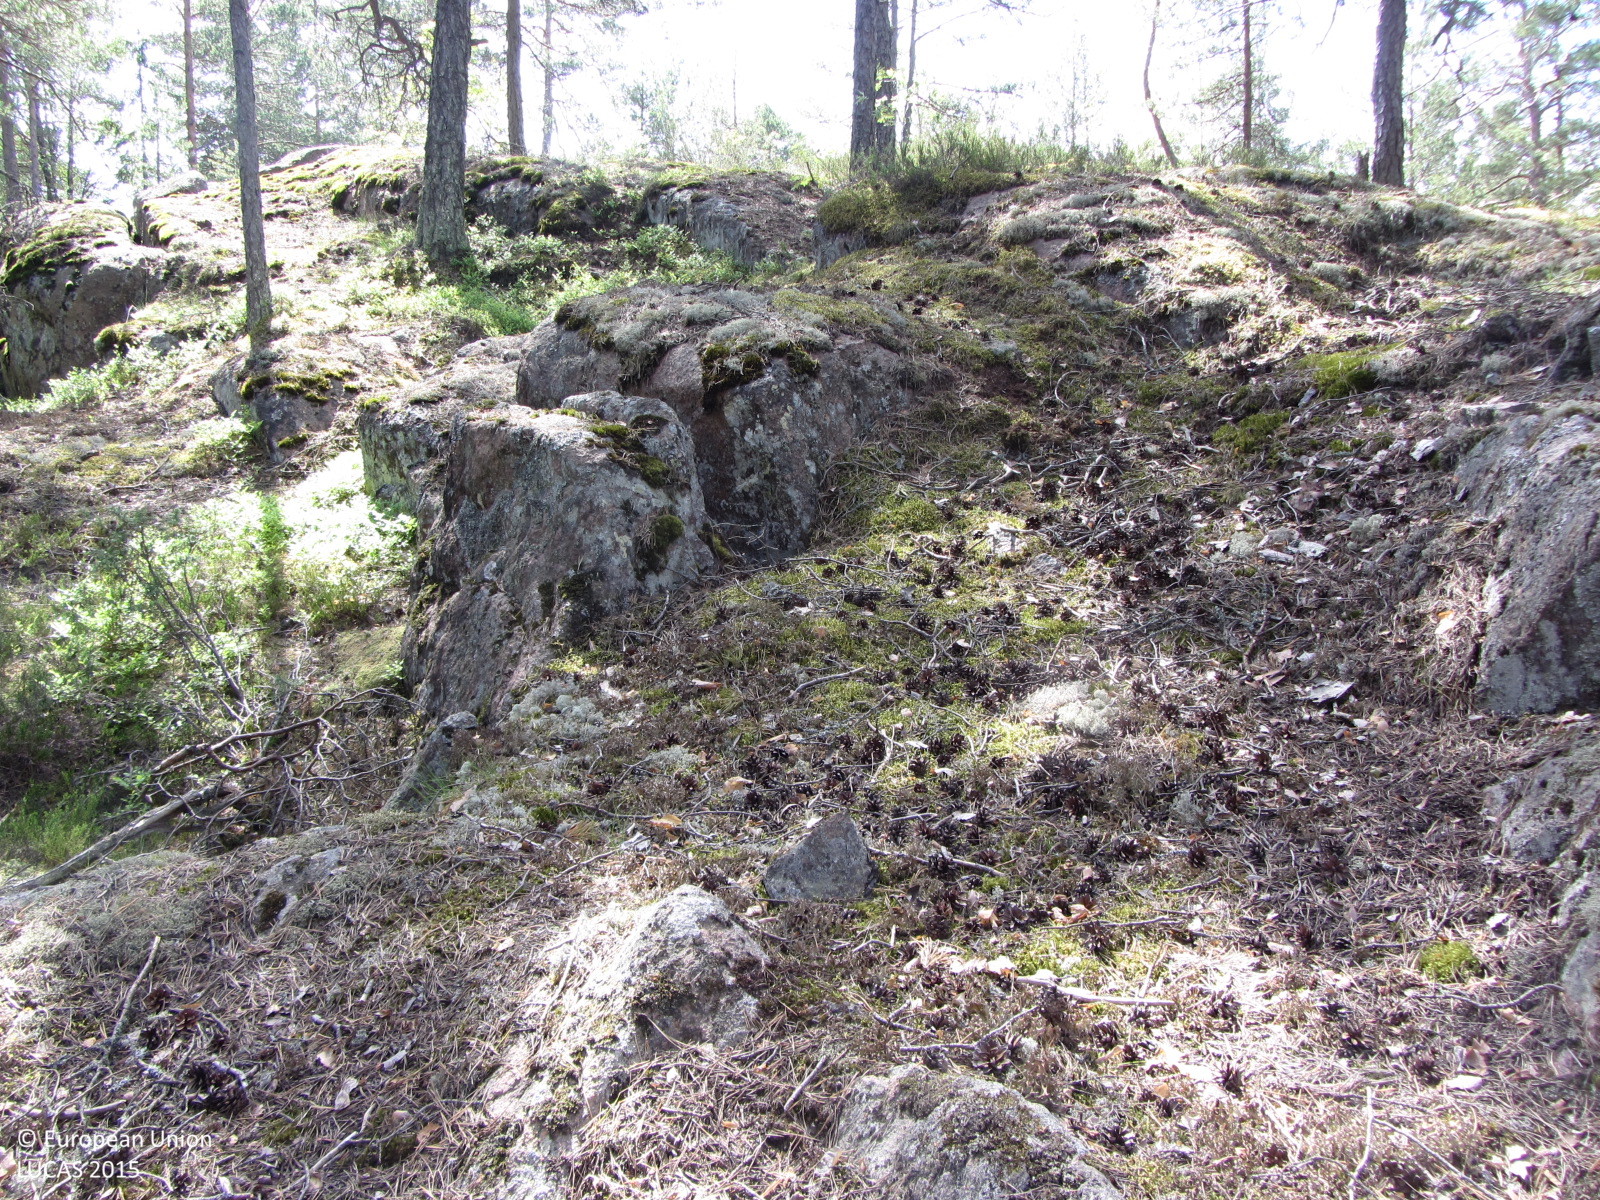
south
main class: Woodland
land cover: Pine dominated coniferous woodland
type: boreal forest
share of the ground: > 75 %
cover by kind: coniferous forest trees 70 %, shrubs 10 %, consolidated bare surface 10 %, broadleaved forest trees 5 %, lichens and mosses 5 %
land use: Forestry
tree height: > 5 m
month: June
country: FI
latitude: 60.1658
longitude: 24.6177
